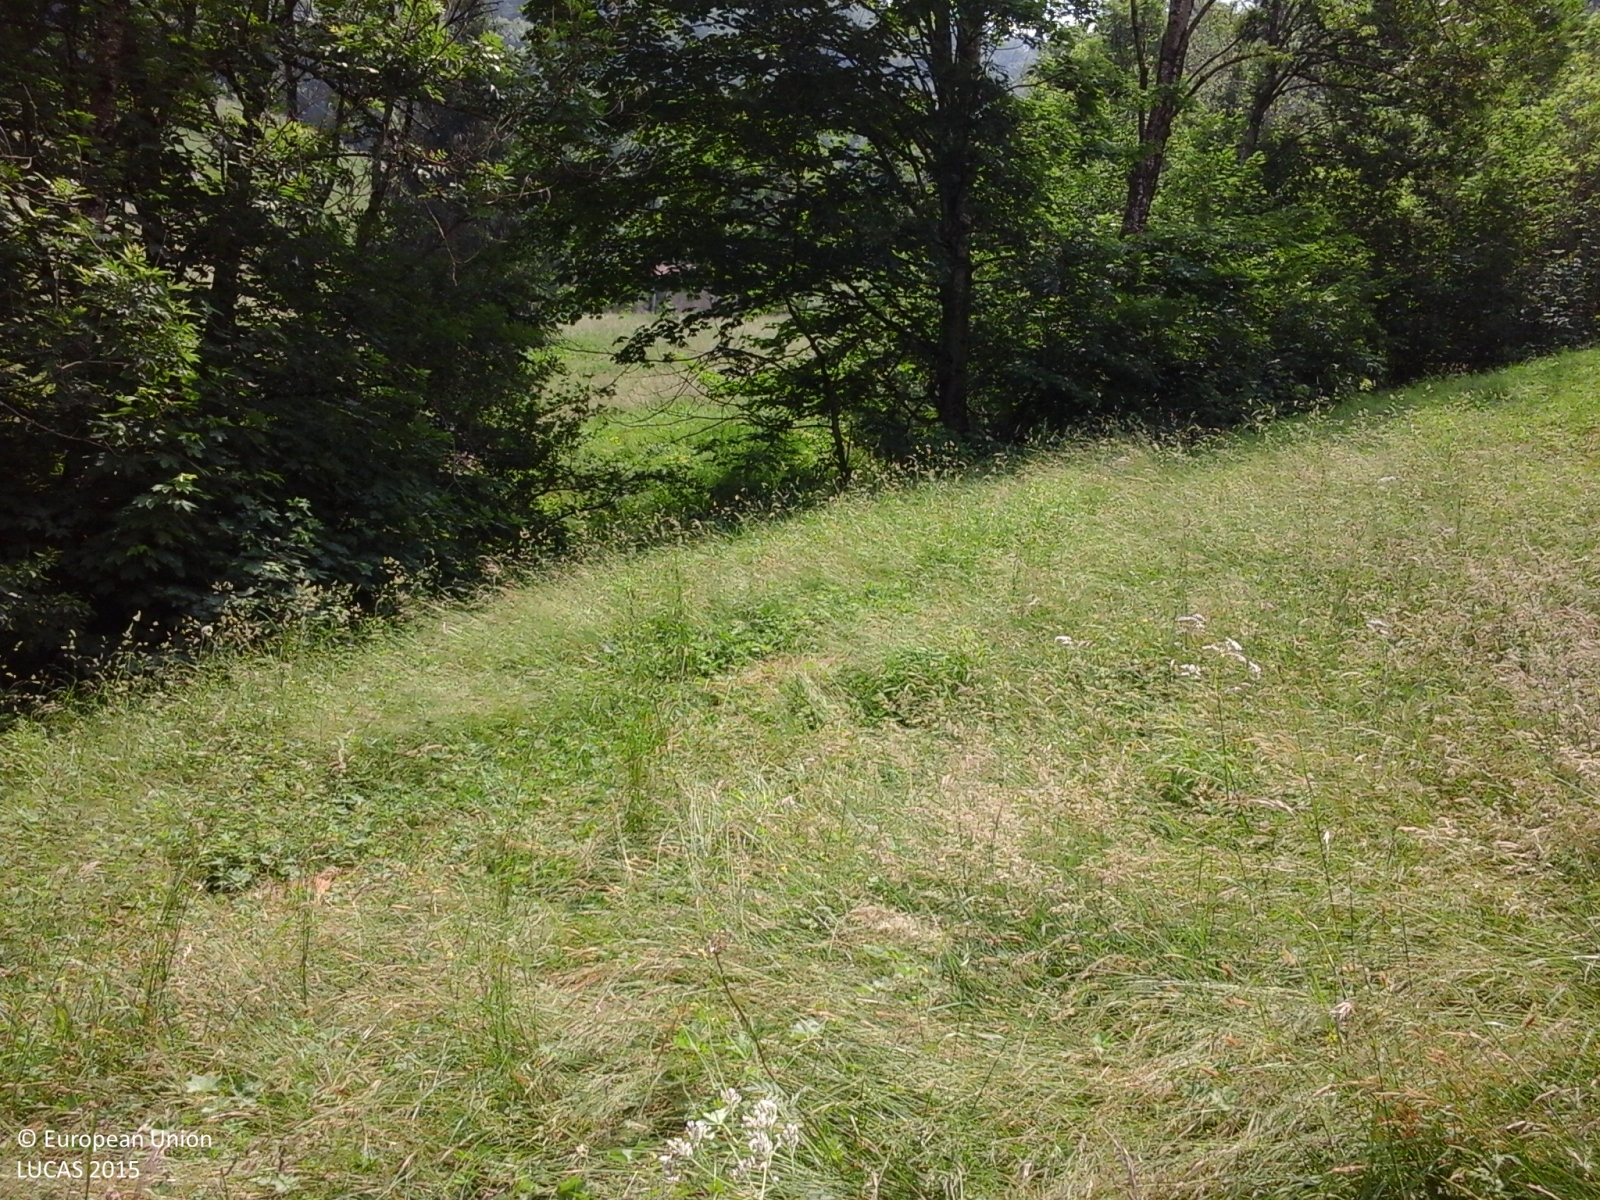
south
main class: Grassland
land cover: Grassland without tree/shrub cover
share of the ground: > 75 %
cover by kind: herbaceous plants 100 %
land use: Agriculture (excluding fallow land and kitchen gardens)
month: June
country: IT
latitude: 45.7565
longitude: 10.2182
